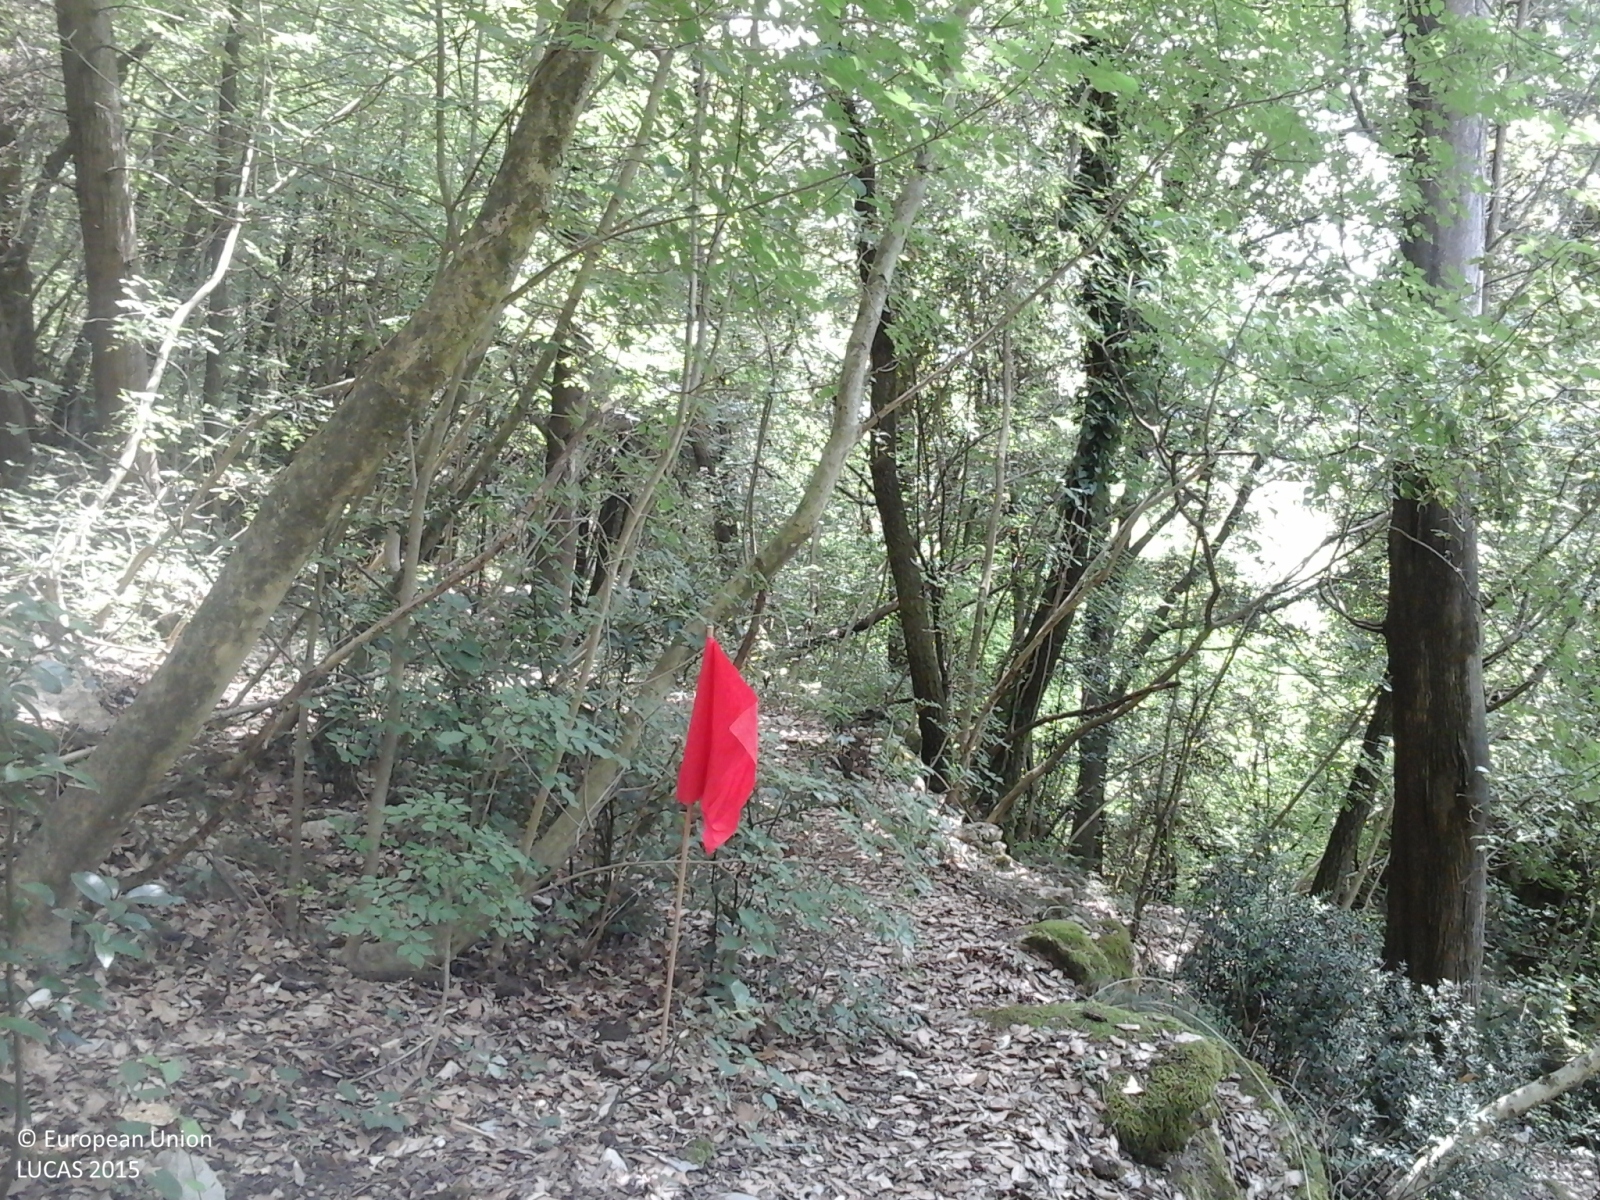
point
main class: Woodland
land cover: Other mixed woodland
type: thermophilous deciduous forest
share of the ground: > 75 %
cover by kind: broadleaved forest trees 75 %, coniferous forest trees 25 %
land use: Forestry
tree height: > 5 m
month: June
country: IT
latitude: 43.9303
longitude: 11.0561
